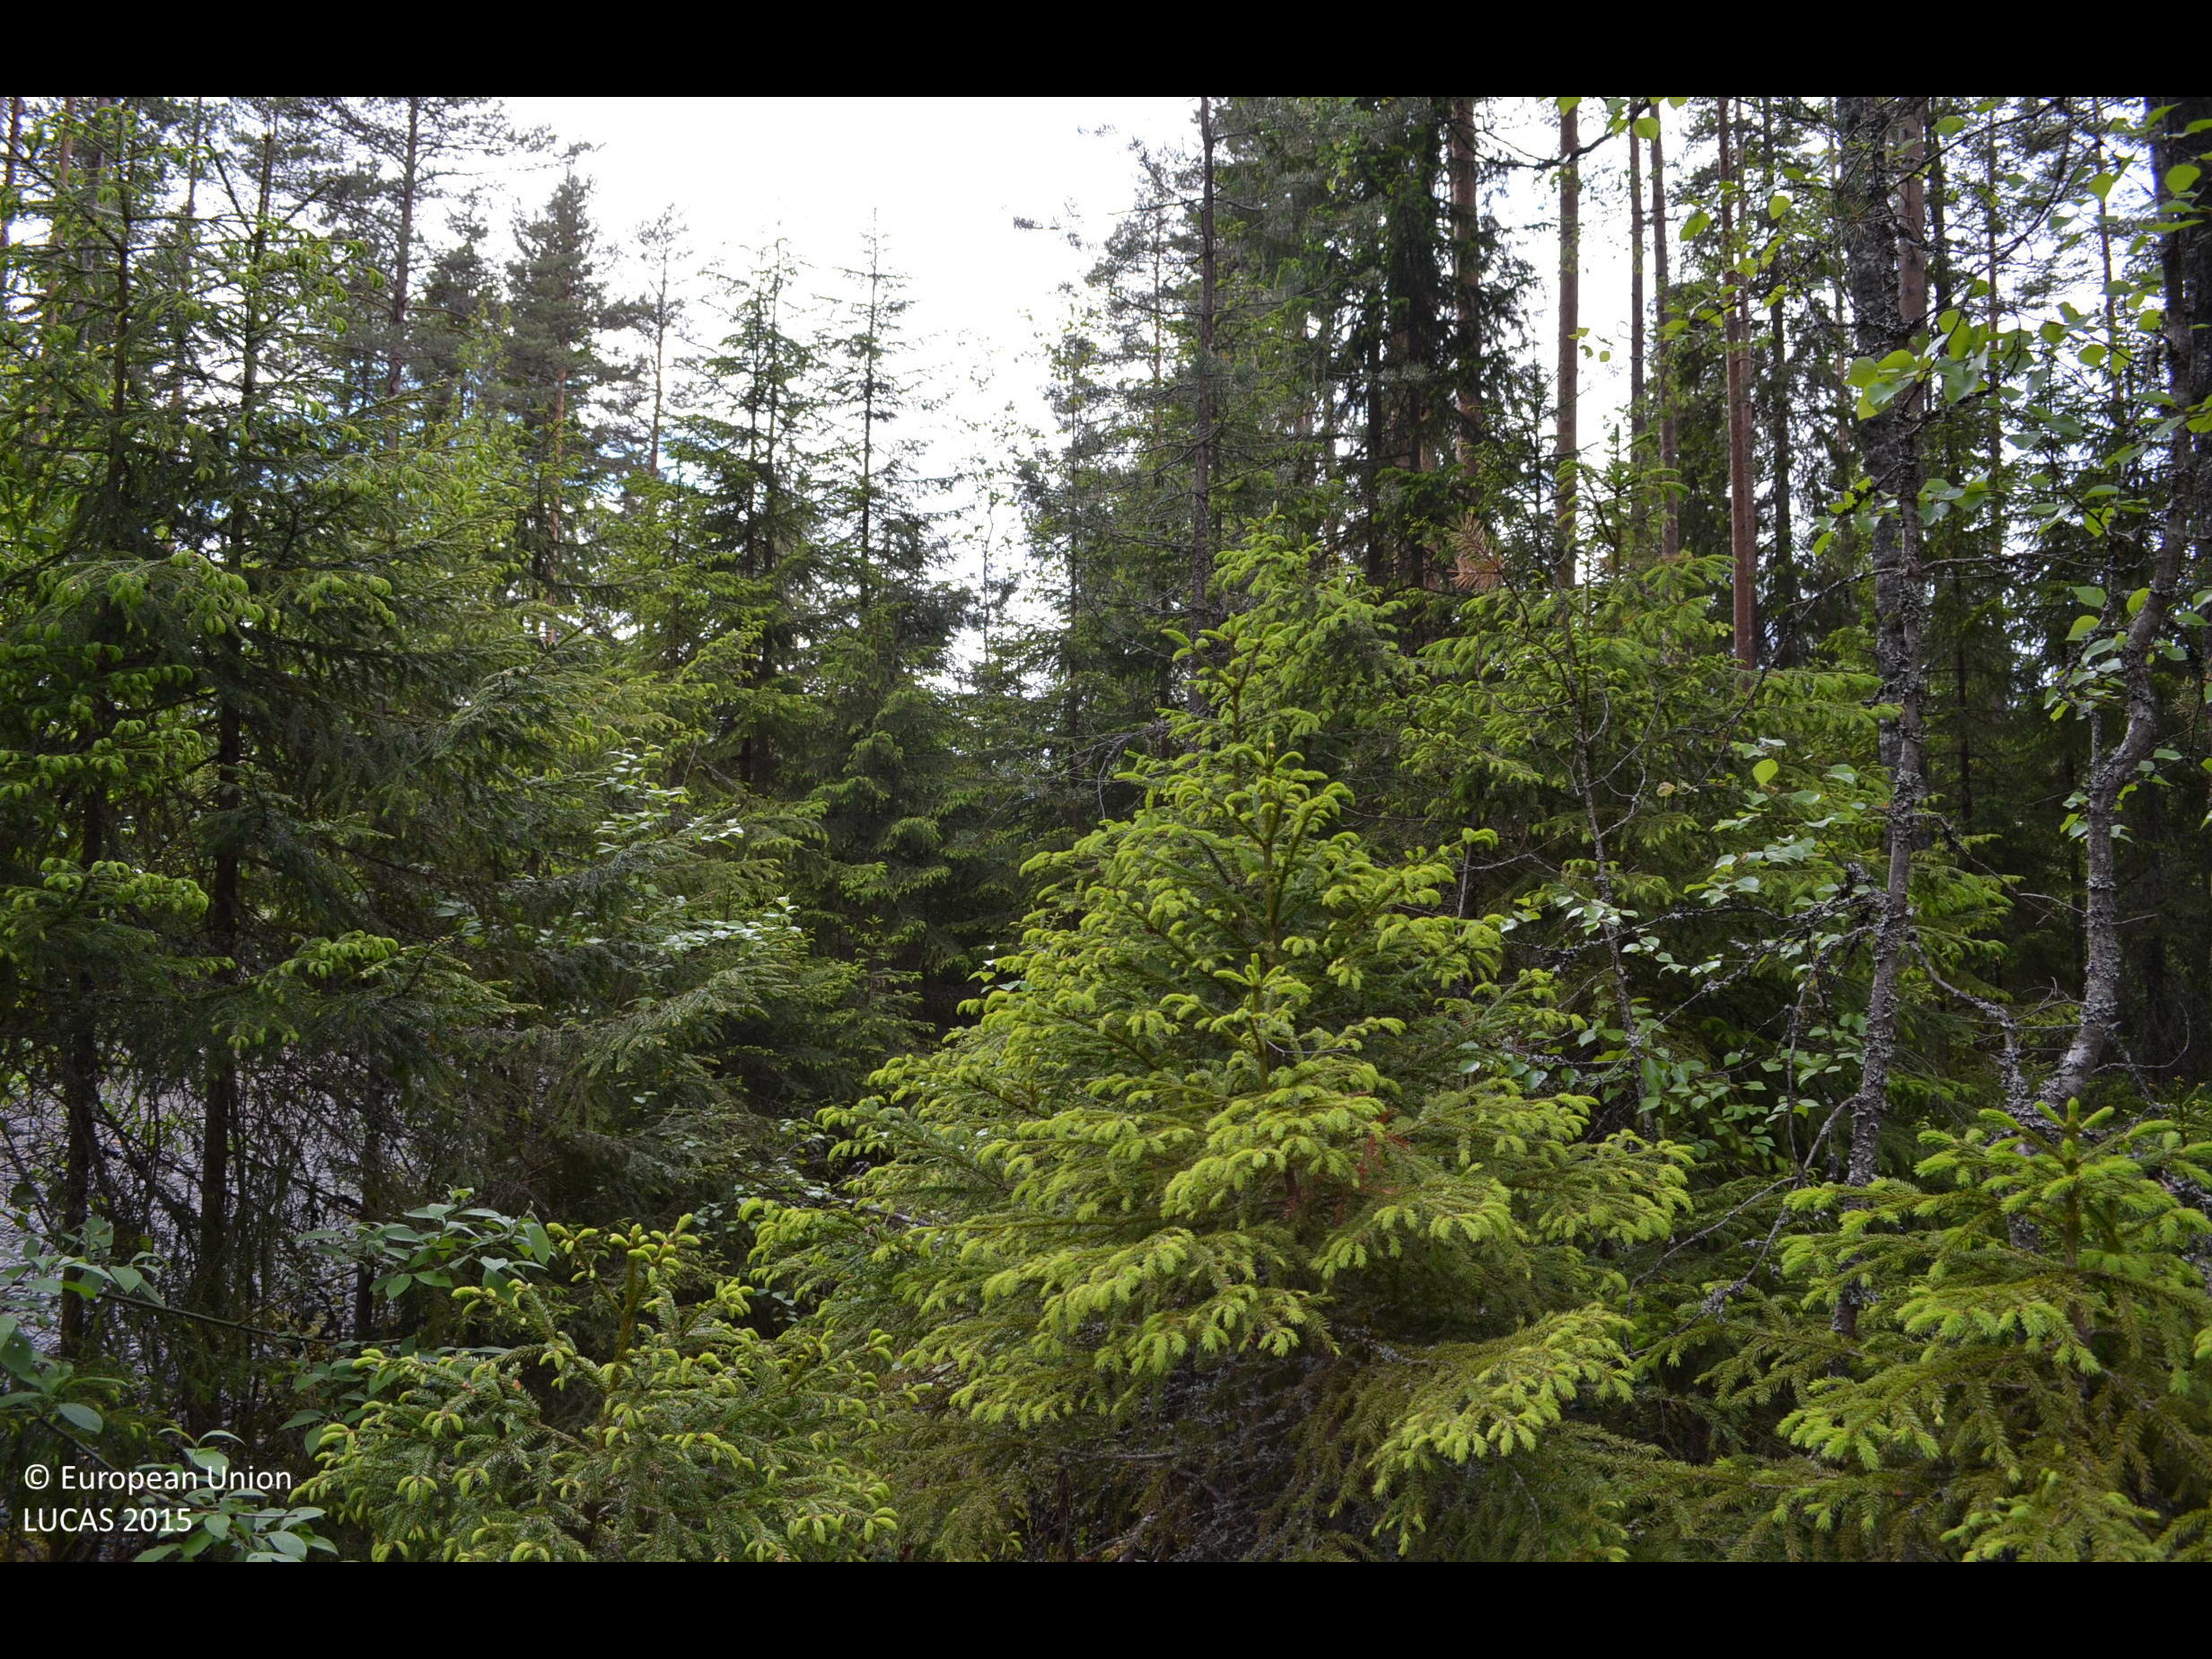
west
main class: Woodland
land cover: Other coniferous woodland
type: boreal forest
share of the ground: > 75 %
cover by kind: coniferous forest trees 65 %, shrubs 20 %, broadleaved forest trees 15 %
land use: Community services
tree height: > 5 m
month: June
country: FI
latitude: 61.9406
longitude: 23.3559
